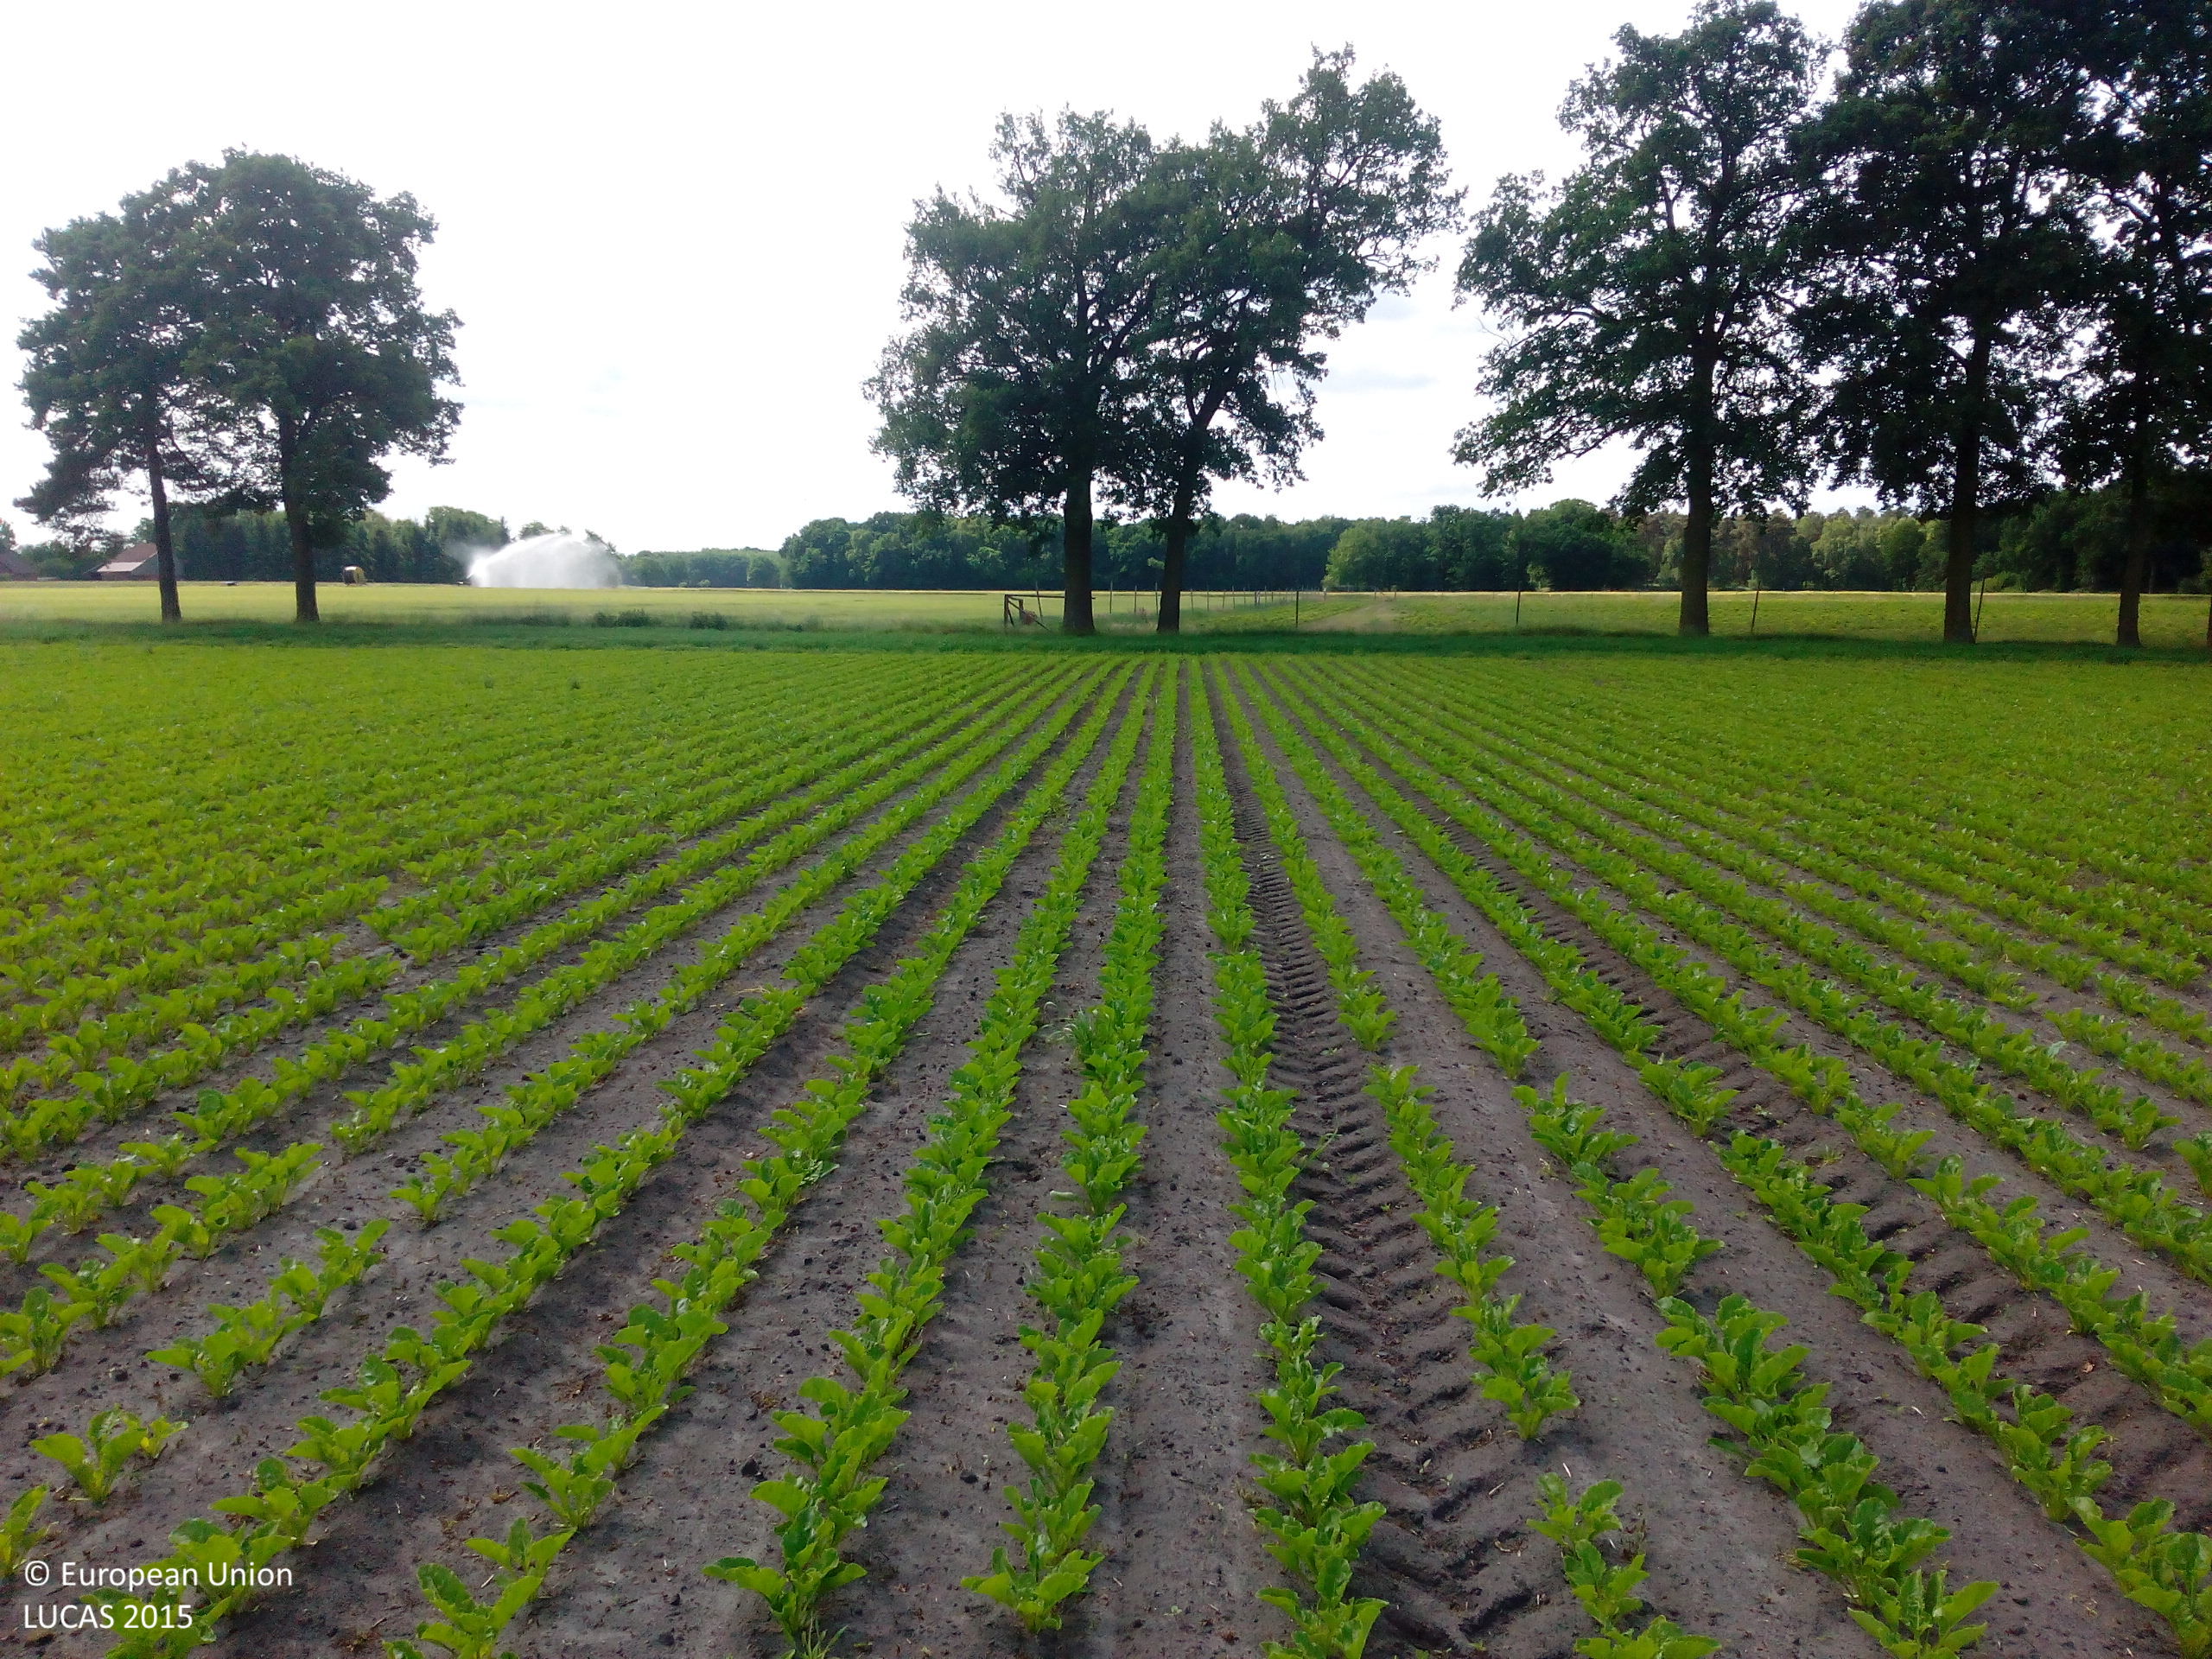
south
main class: Cropland
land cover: Sugar beet
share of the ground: < 10 %
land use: Agriculture (excluding fallow land and kitchen gardens)
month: June
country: DE
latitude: 52.5389
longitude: 10.2800
